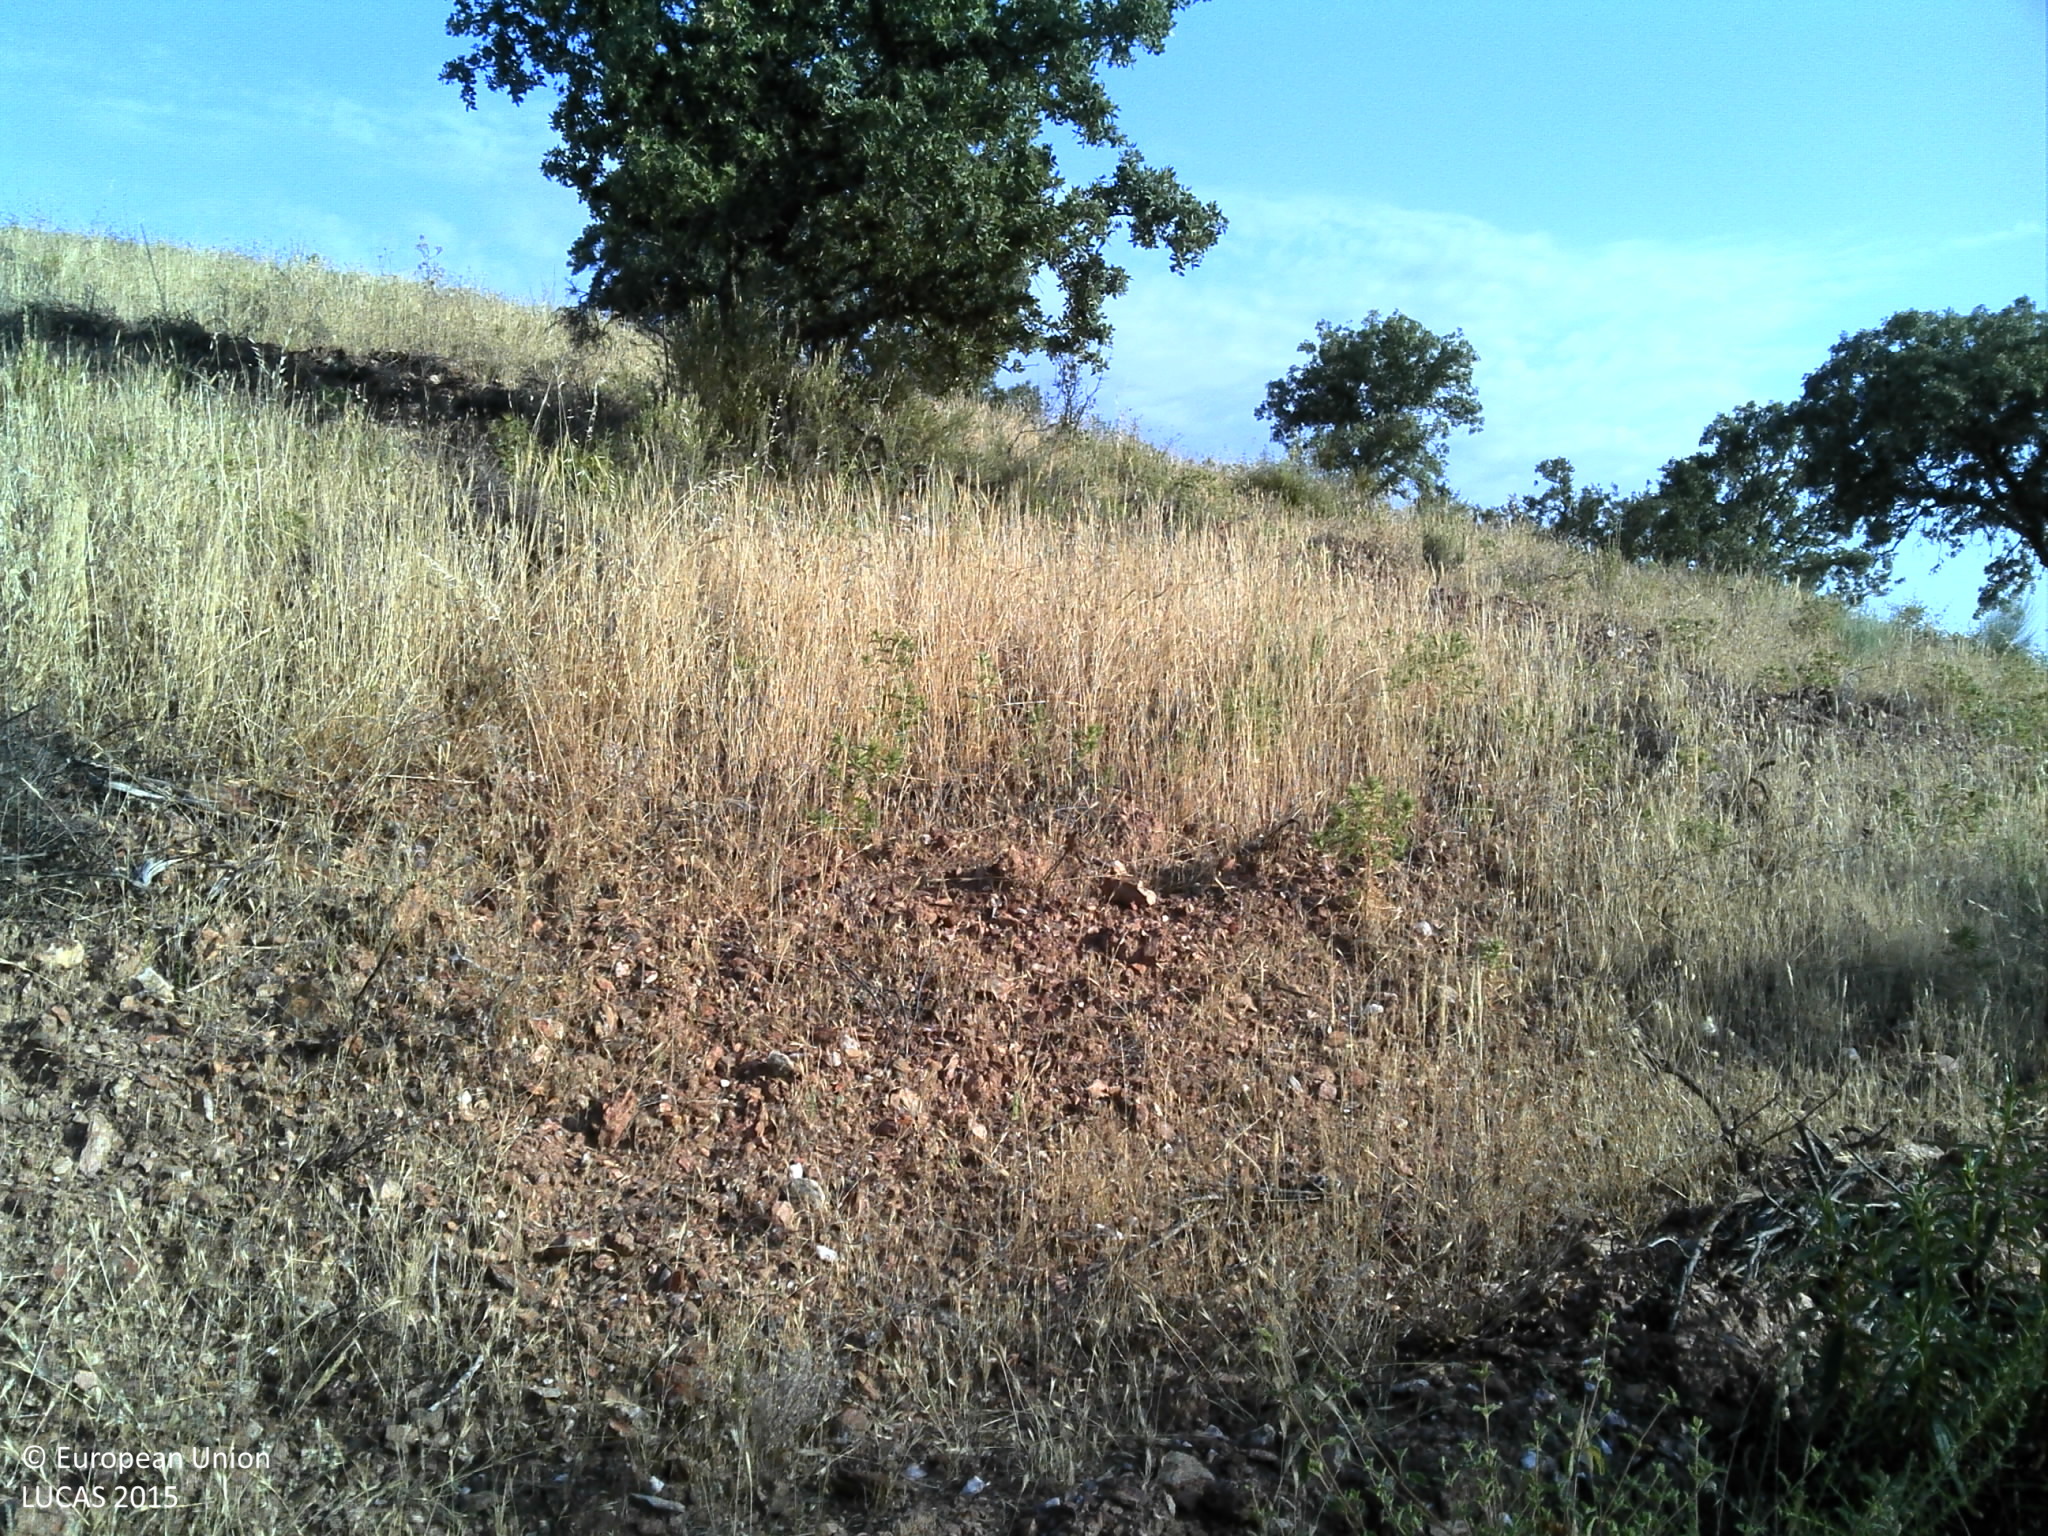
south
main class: Woodland
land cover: Broadleaved woodland
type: broadleaved evergreen forest
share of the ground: 25 - 50 %
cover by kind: herbaceous plants 50 %, broadleaved forest trees 25 %, unconsolidated bare surface 15 %, shrubs 10 %
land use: Forestry
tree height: < 5 m
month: June
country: PT
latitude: 37.7528
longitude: -7.6207
